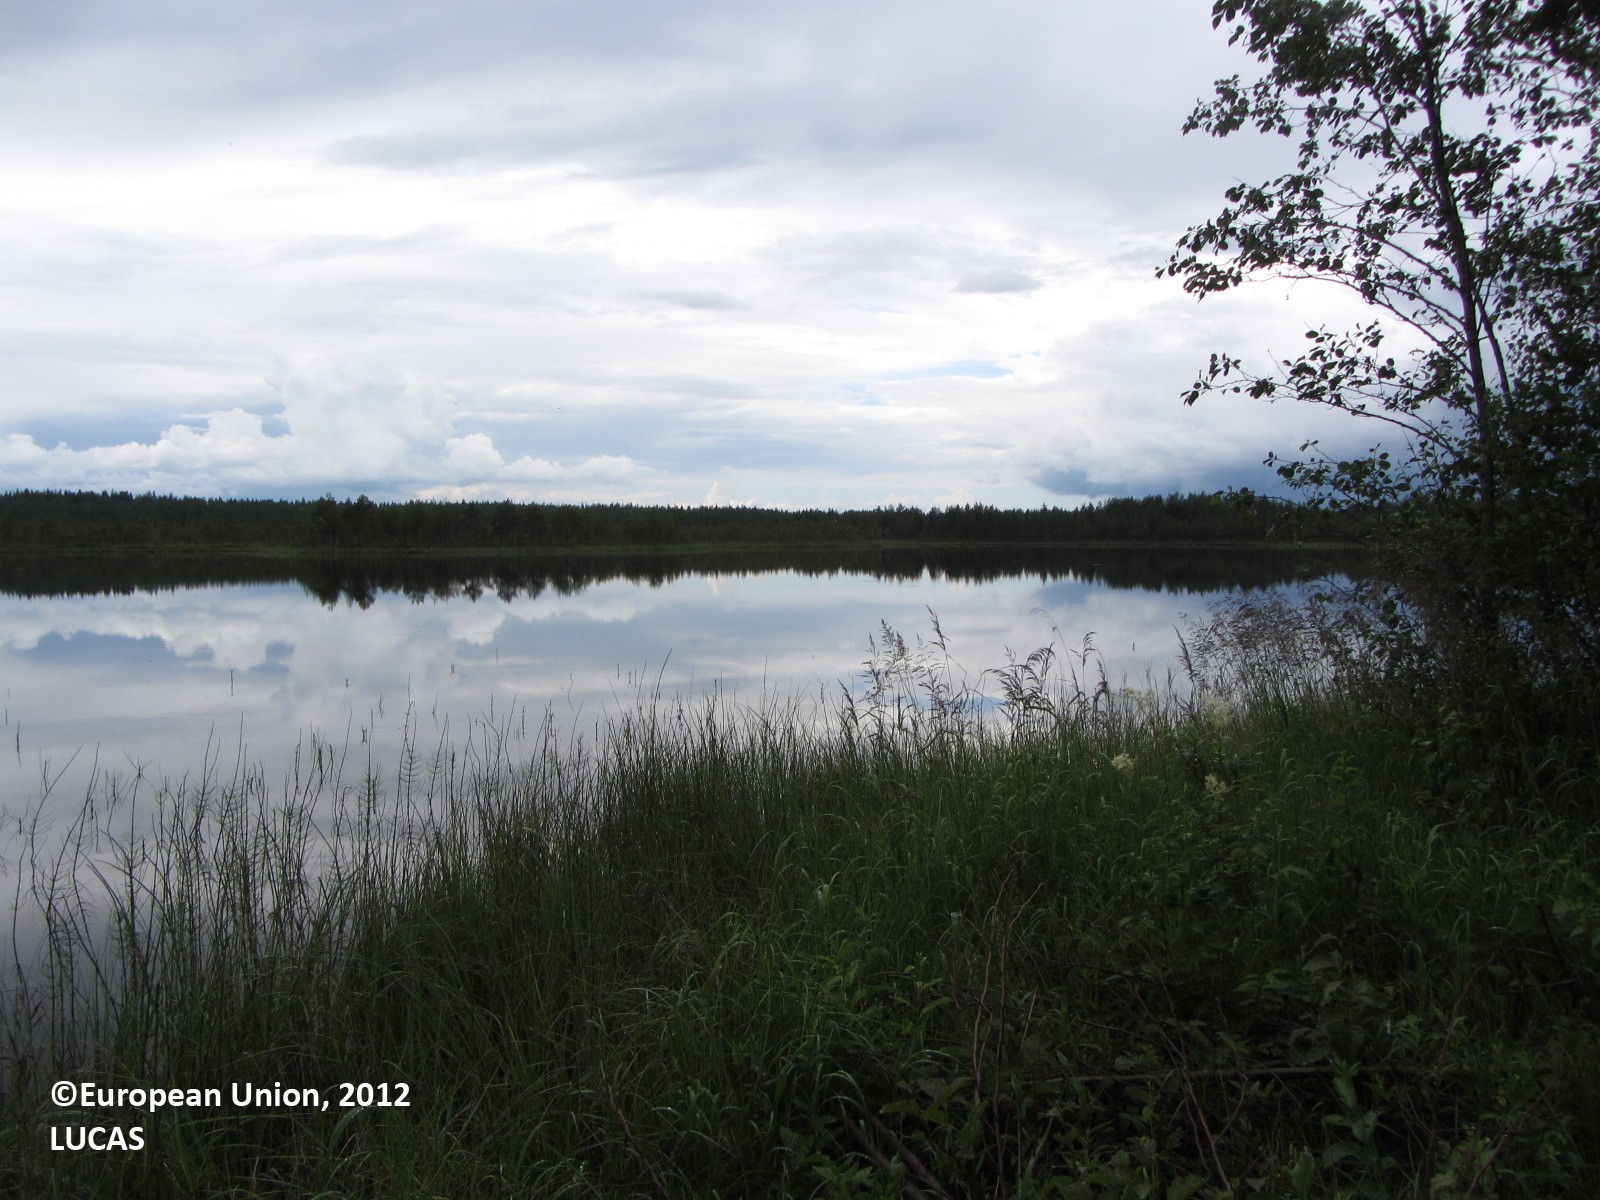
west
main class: Woodland
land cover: Pine dominated coniferous woodland
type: boreal forest
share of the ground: 50 - 75 %
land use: Forestry
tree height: > 5 m
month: July
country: FI
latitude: 63.5893
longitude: 25.3511
